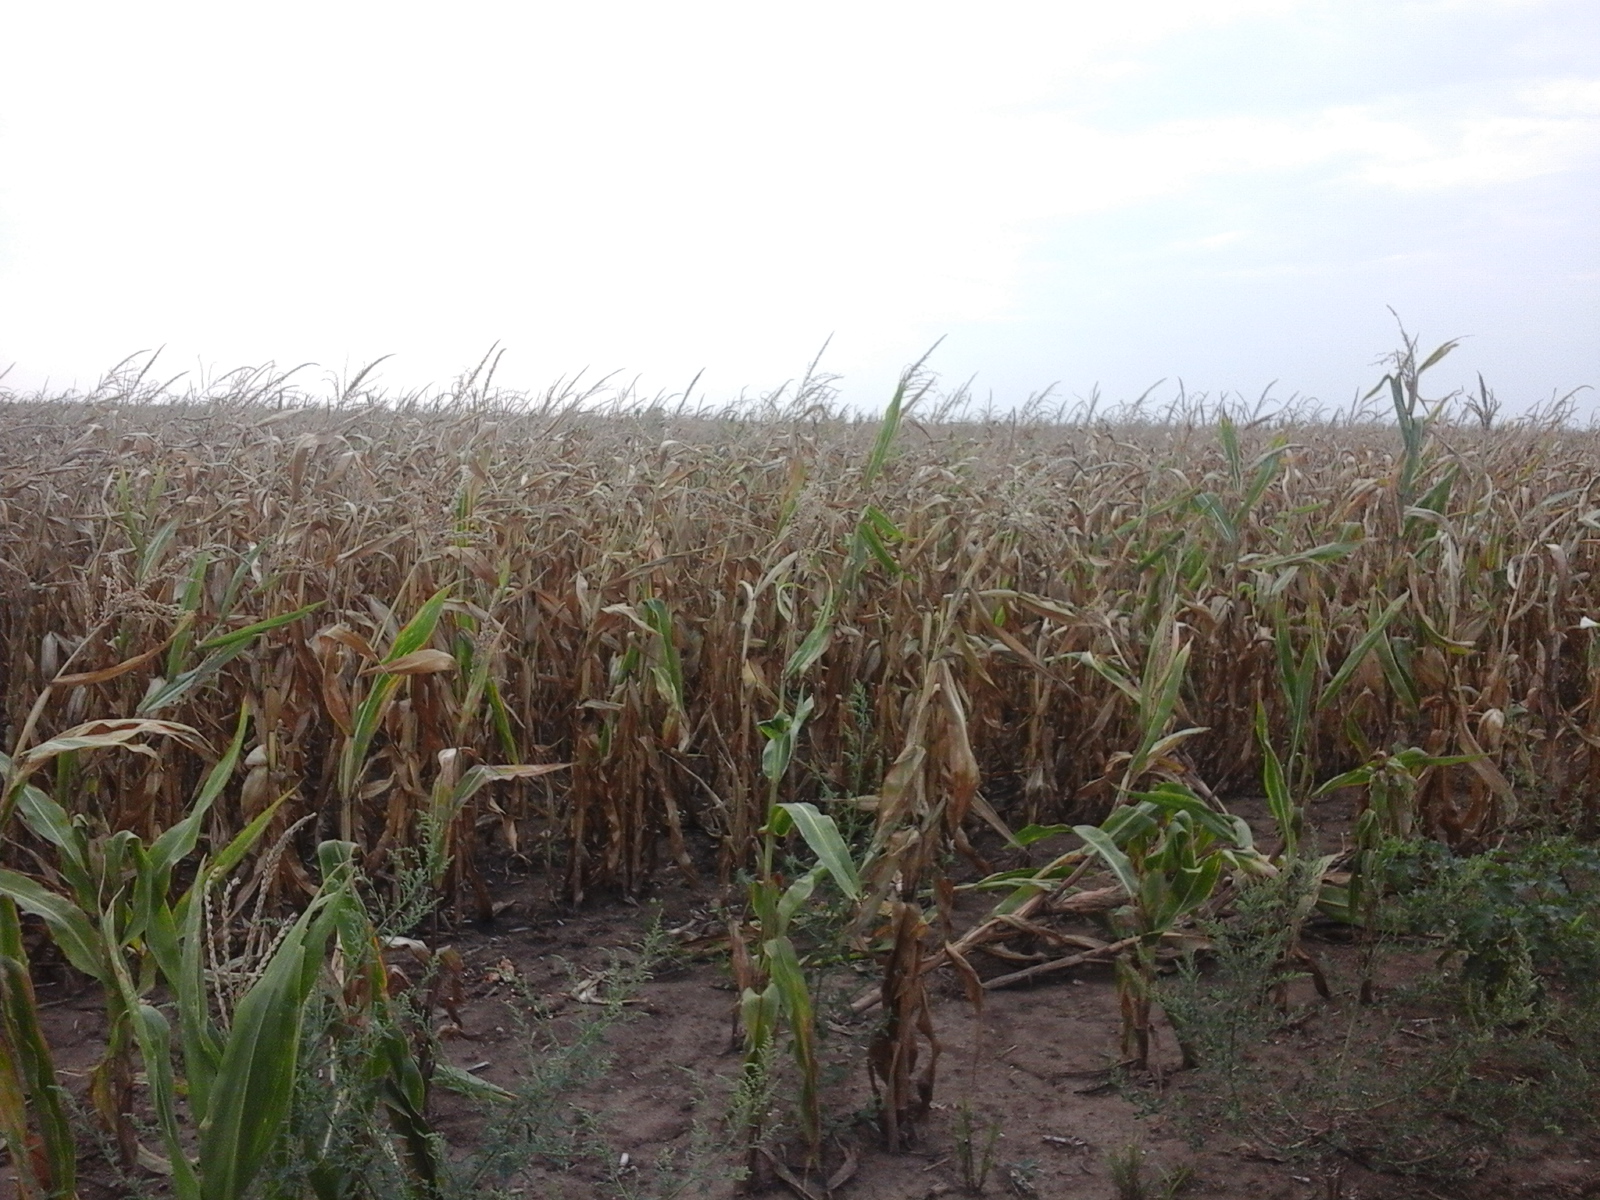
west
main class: Cropland
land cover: Maize
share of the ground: > 75 %
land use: Agriculture (excluding fallow land and kitchen gardens)
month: August
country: RO
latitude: 46.2515
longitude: 21.5426
